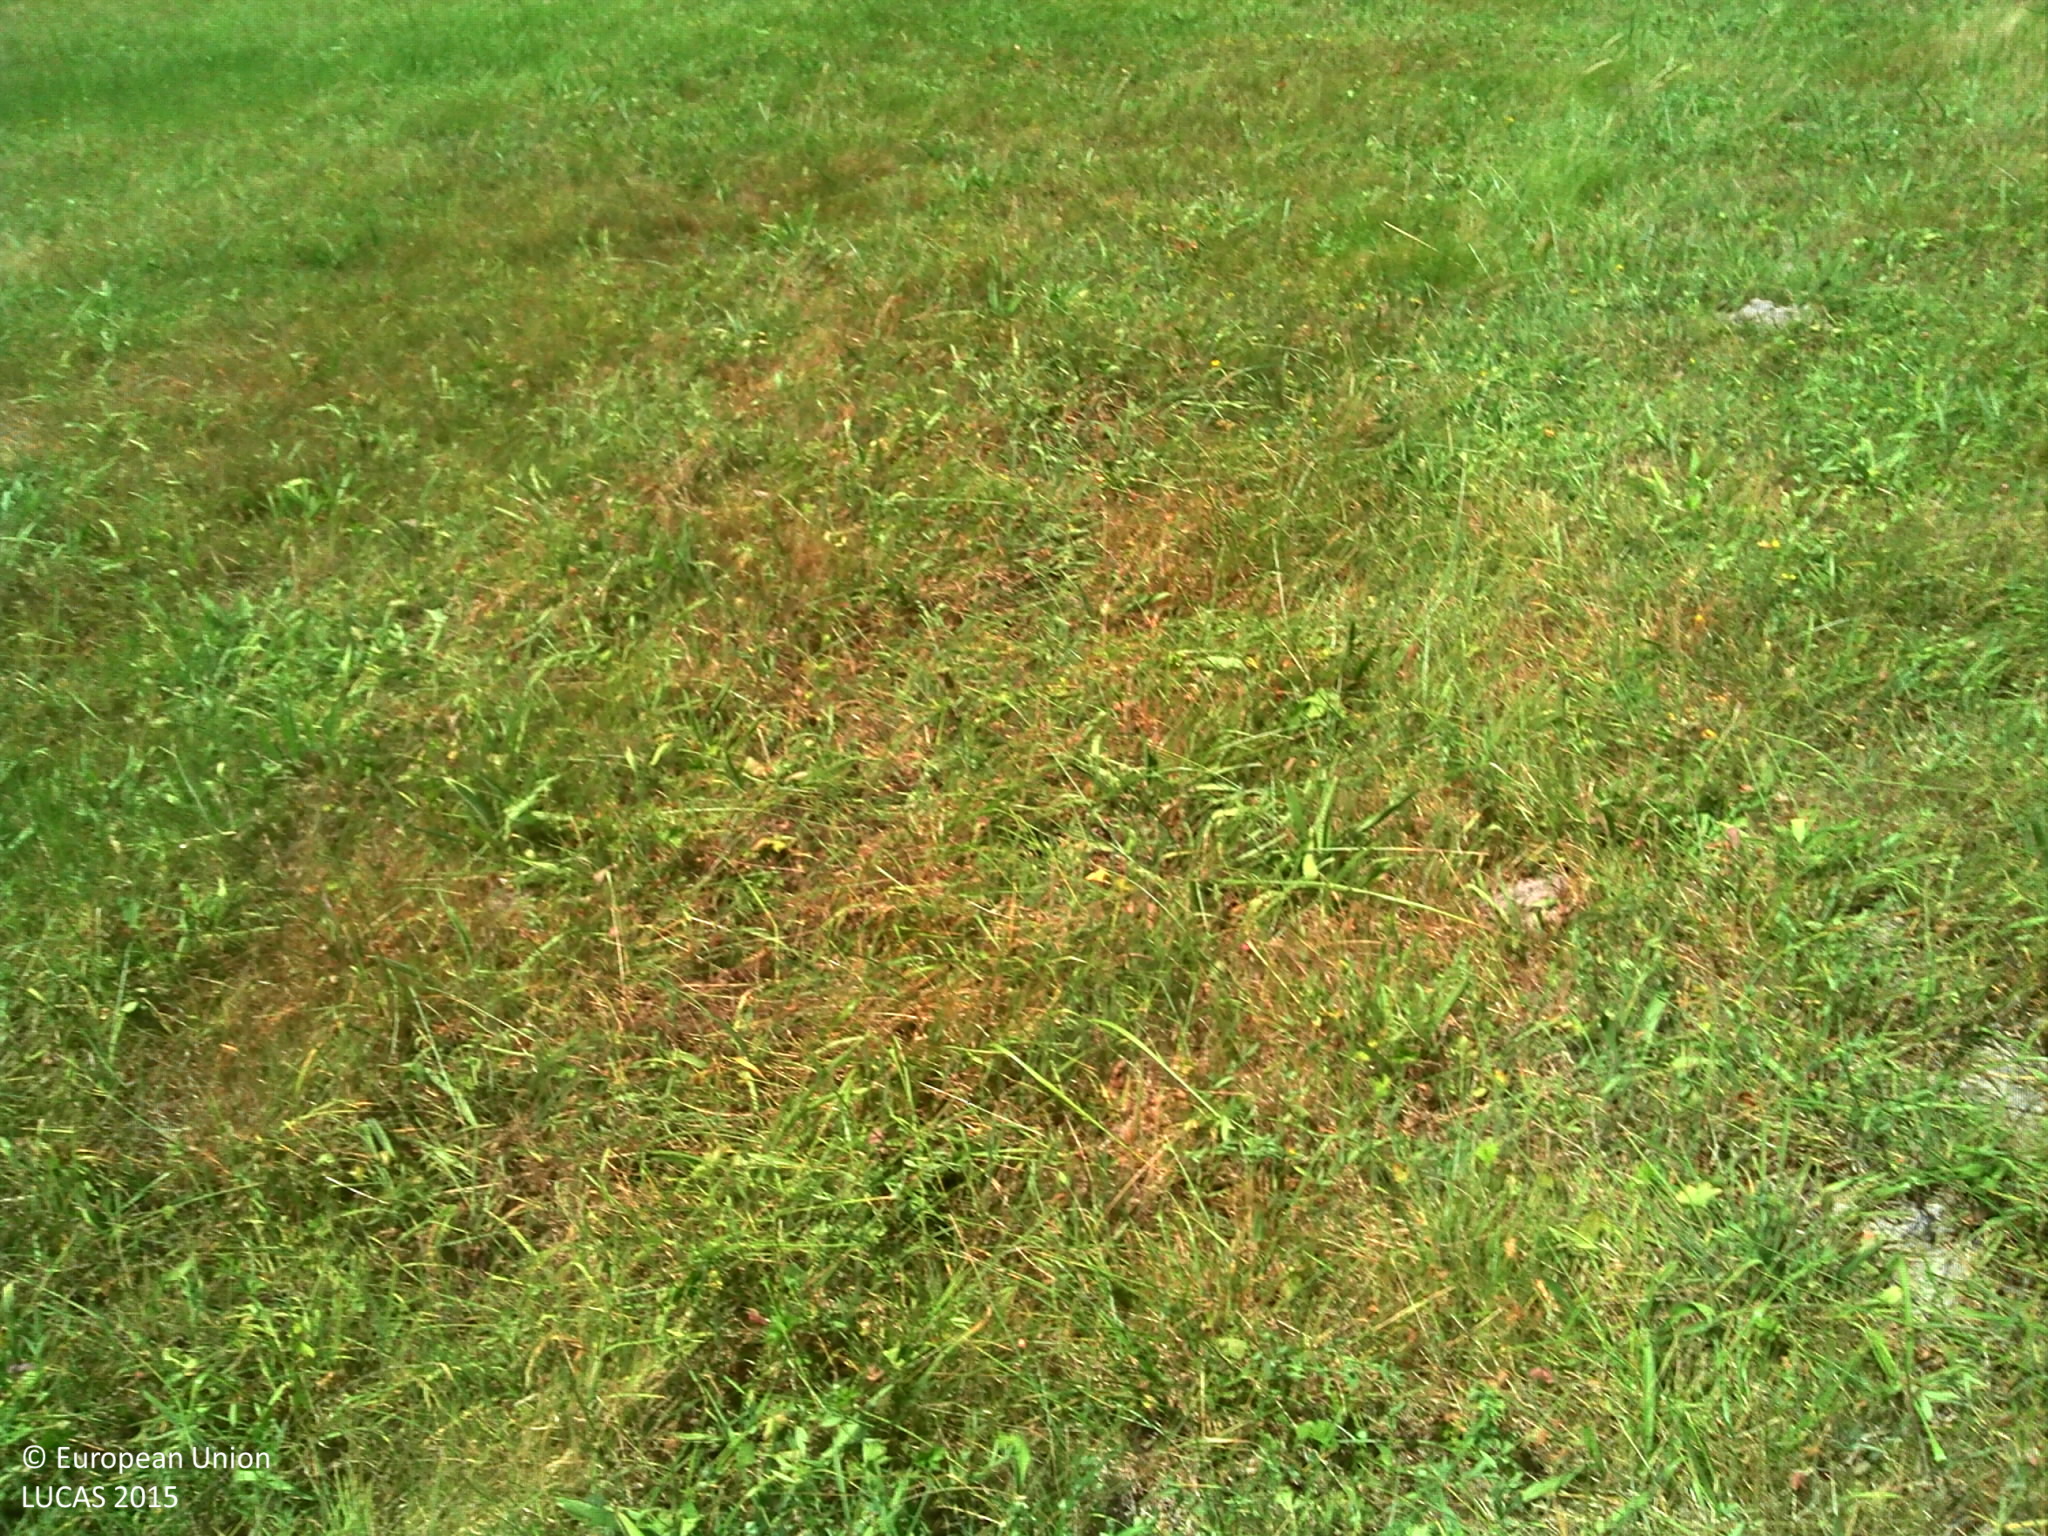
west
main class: Grassland
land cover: Grassland without tree/shrub cover
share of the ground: > 75 %
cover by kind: herbaceous plants 100 %
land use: Agriculture (excluding fallow land and kitchen gardens)
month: July
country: FR
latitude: 46.4637
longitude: 2.1938
